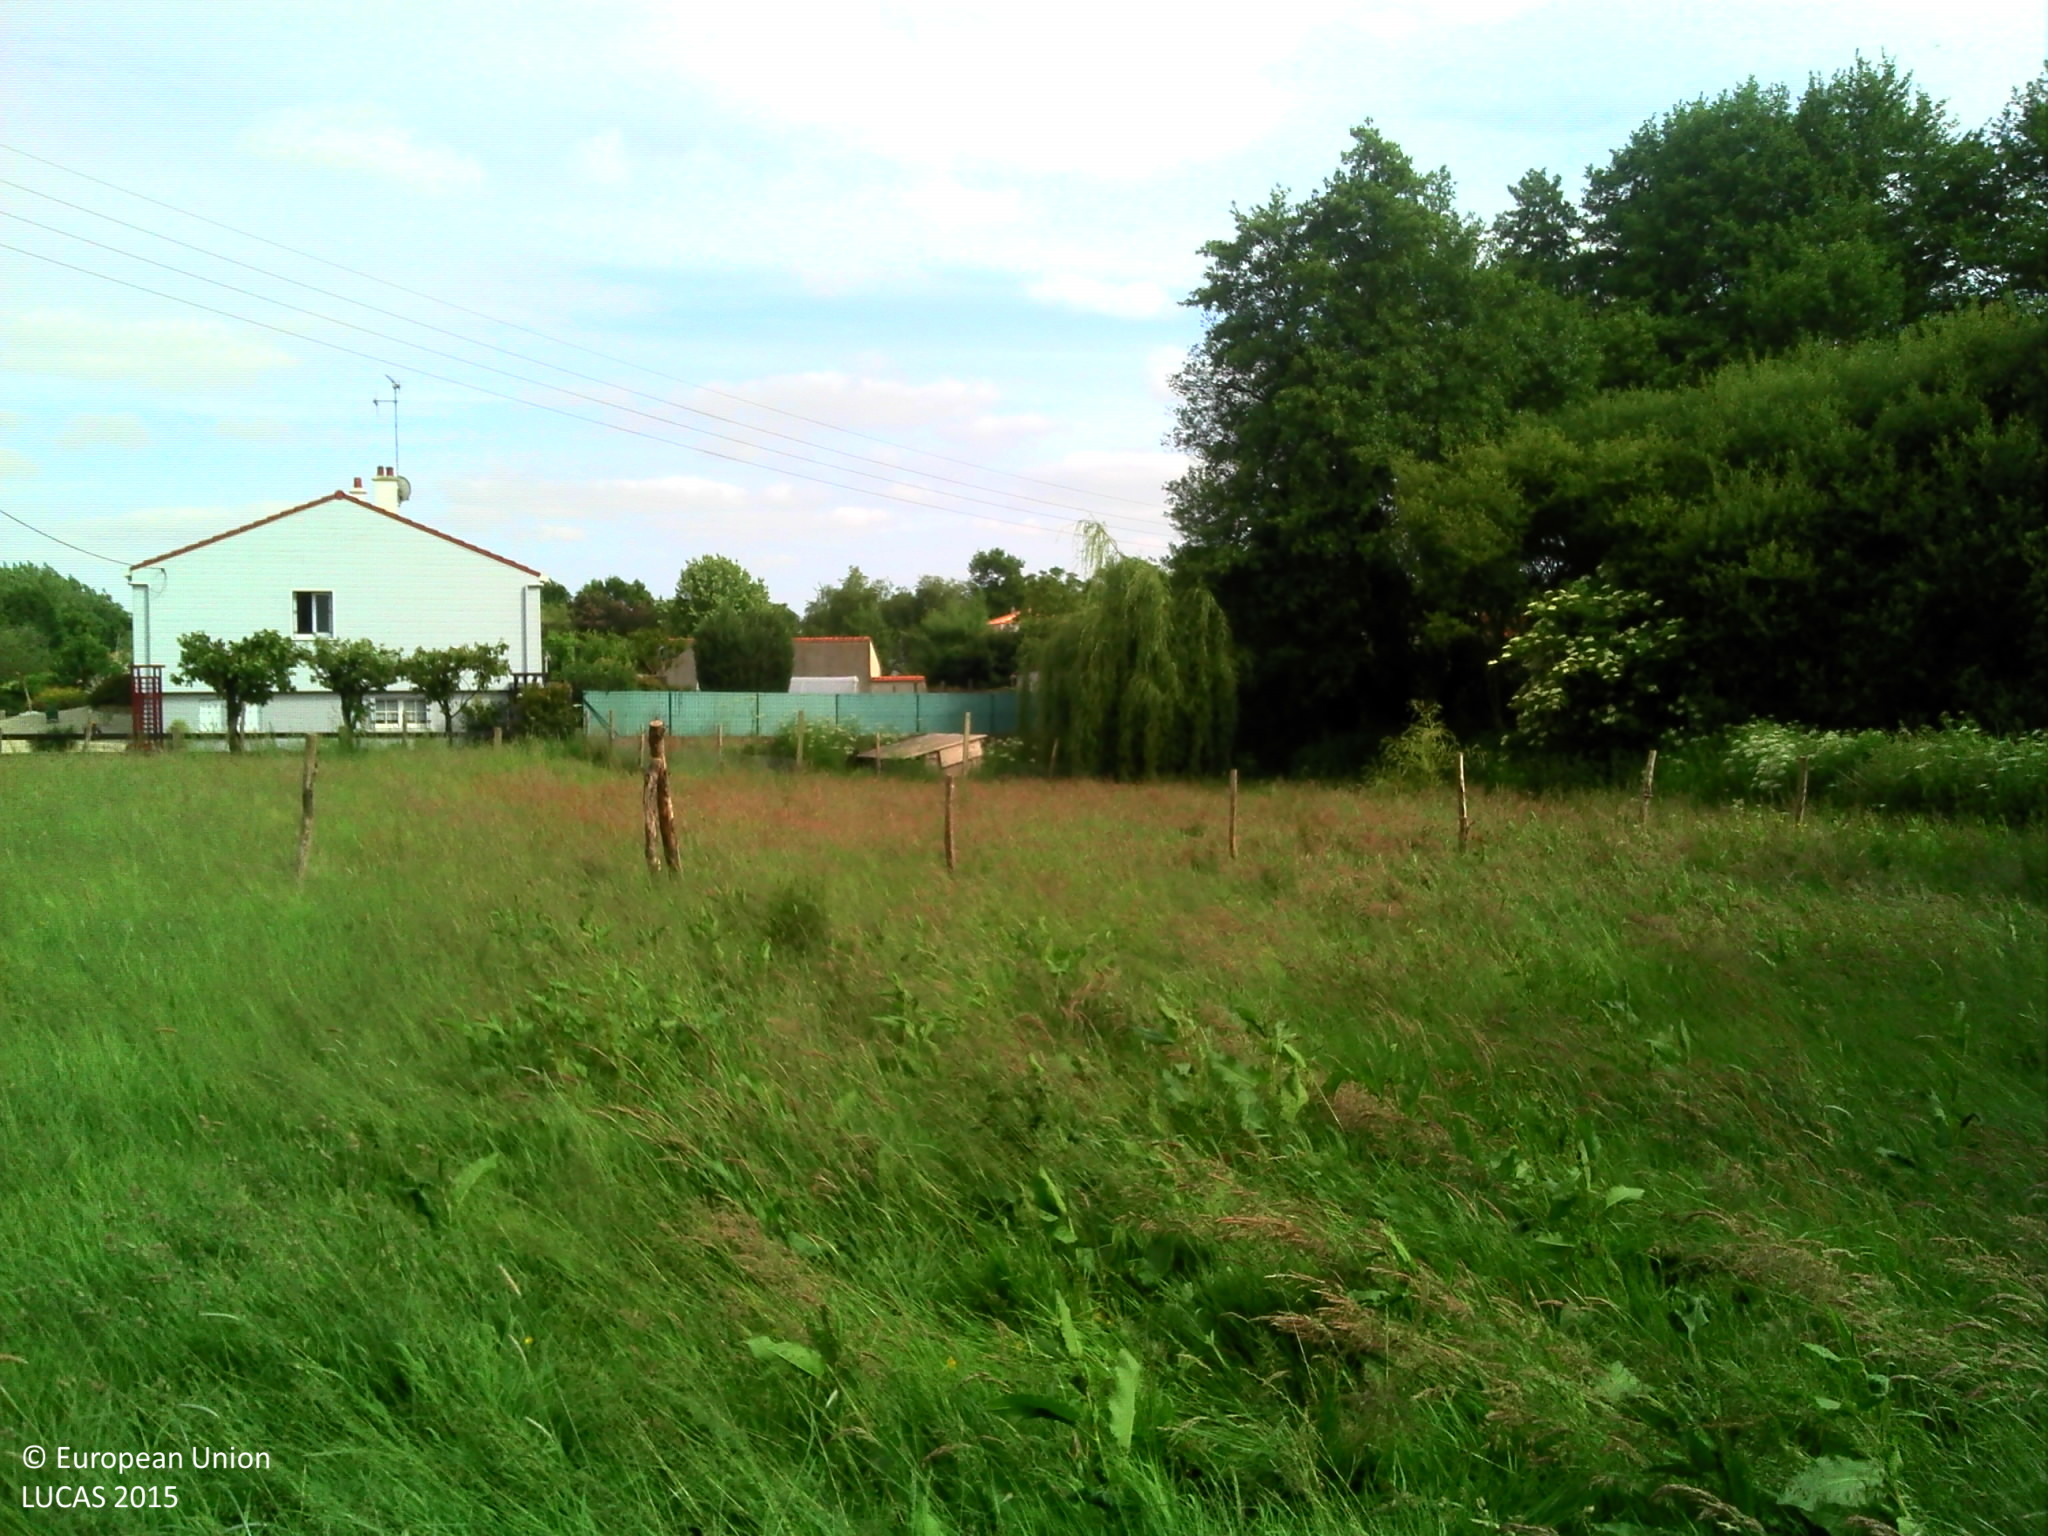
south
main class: Grassland
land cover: Grassland with sparse tree/shrub cover
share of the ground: > 75 %
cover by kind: herbaceous plants 90 %, broadleaved forest trees 5 %, shrubs 5 %
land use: Residential
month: May
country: FR
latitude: 46.9967
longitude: -1.2013
